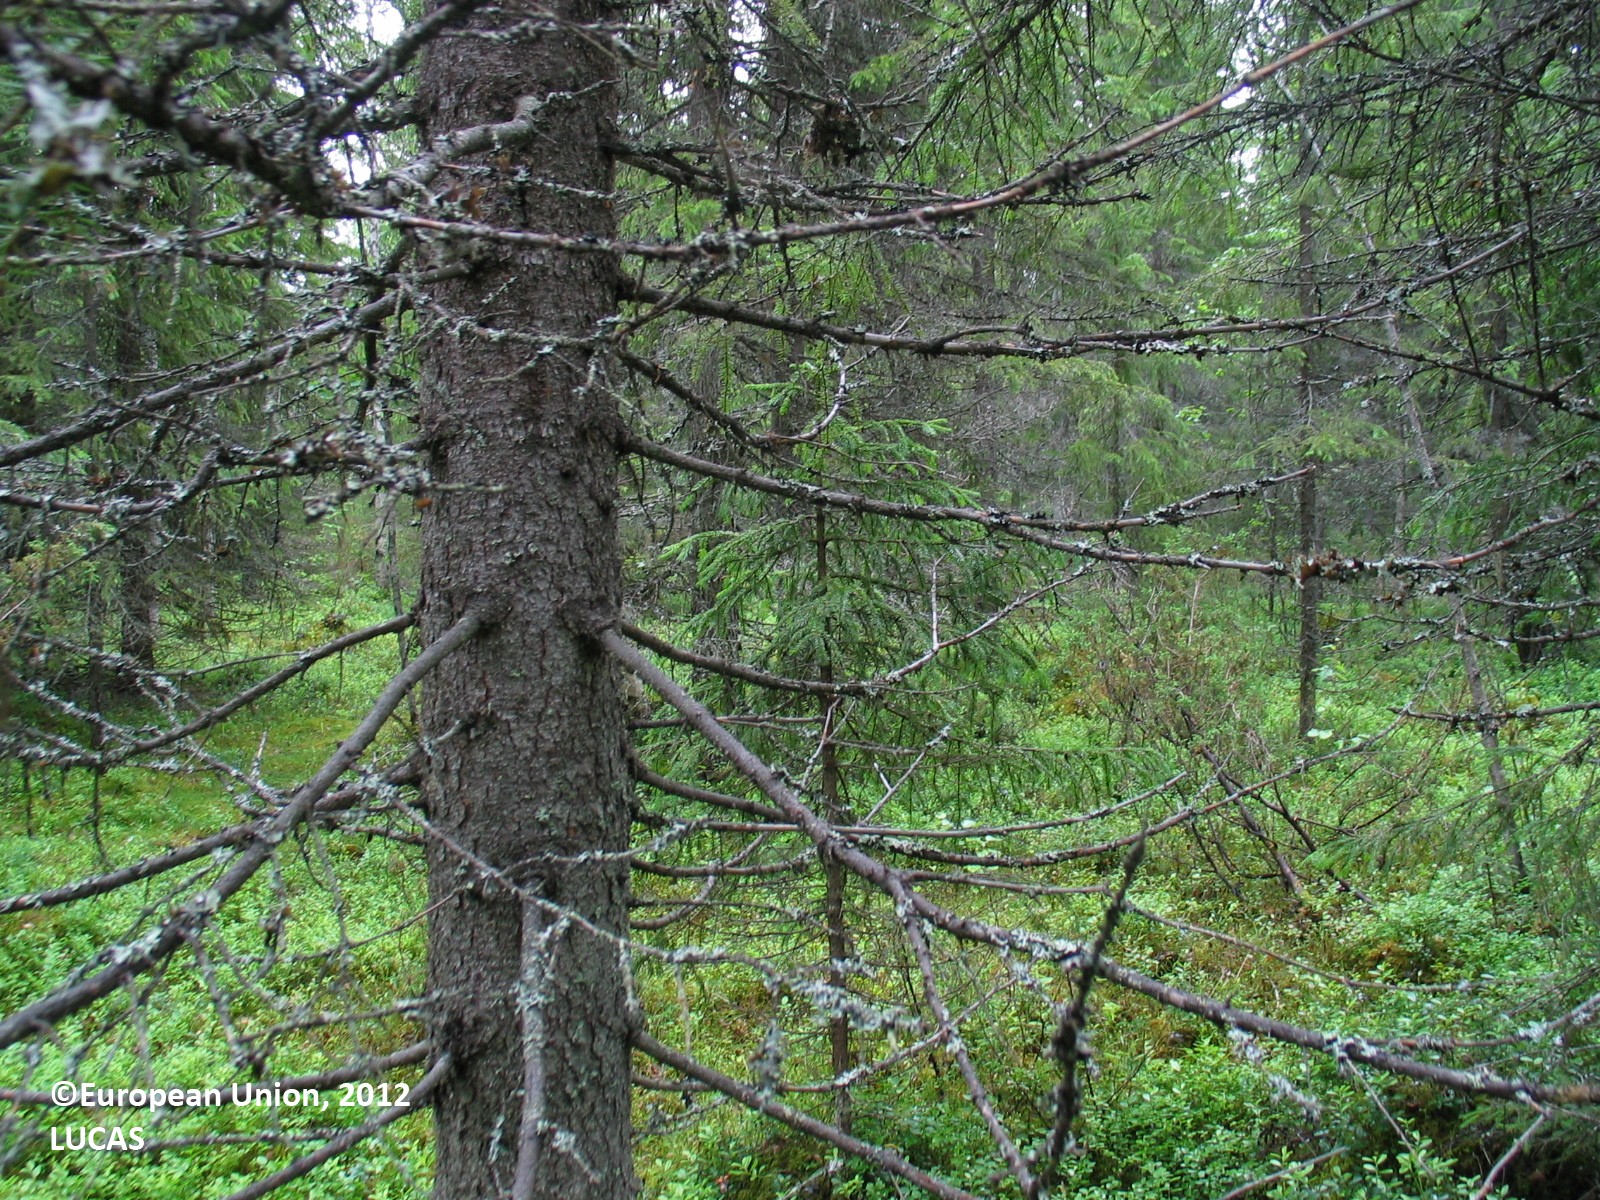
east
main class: Woodland
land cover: Spruce dominated coniferous woodland
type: boreal forest
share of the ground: 50 - 75 %
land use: Forestry
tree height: > 5 m
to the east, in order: Spruce dominated coniferous woodland; Other mixed woodland; Tracks; Grass margins; Ditches and canals; Other mixed woodland; Grassland with sparse tree/shrub cover; Grassland without tree/shrub cover; Other mixed woodland
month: July
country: FI
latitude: 65.9839
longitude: 25.0571
